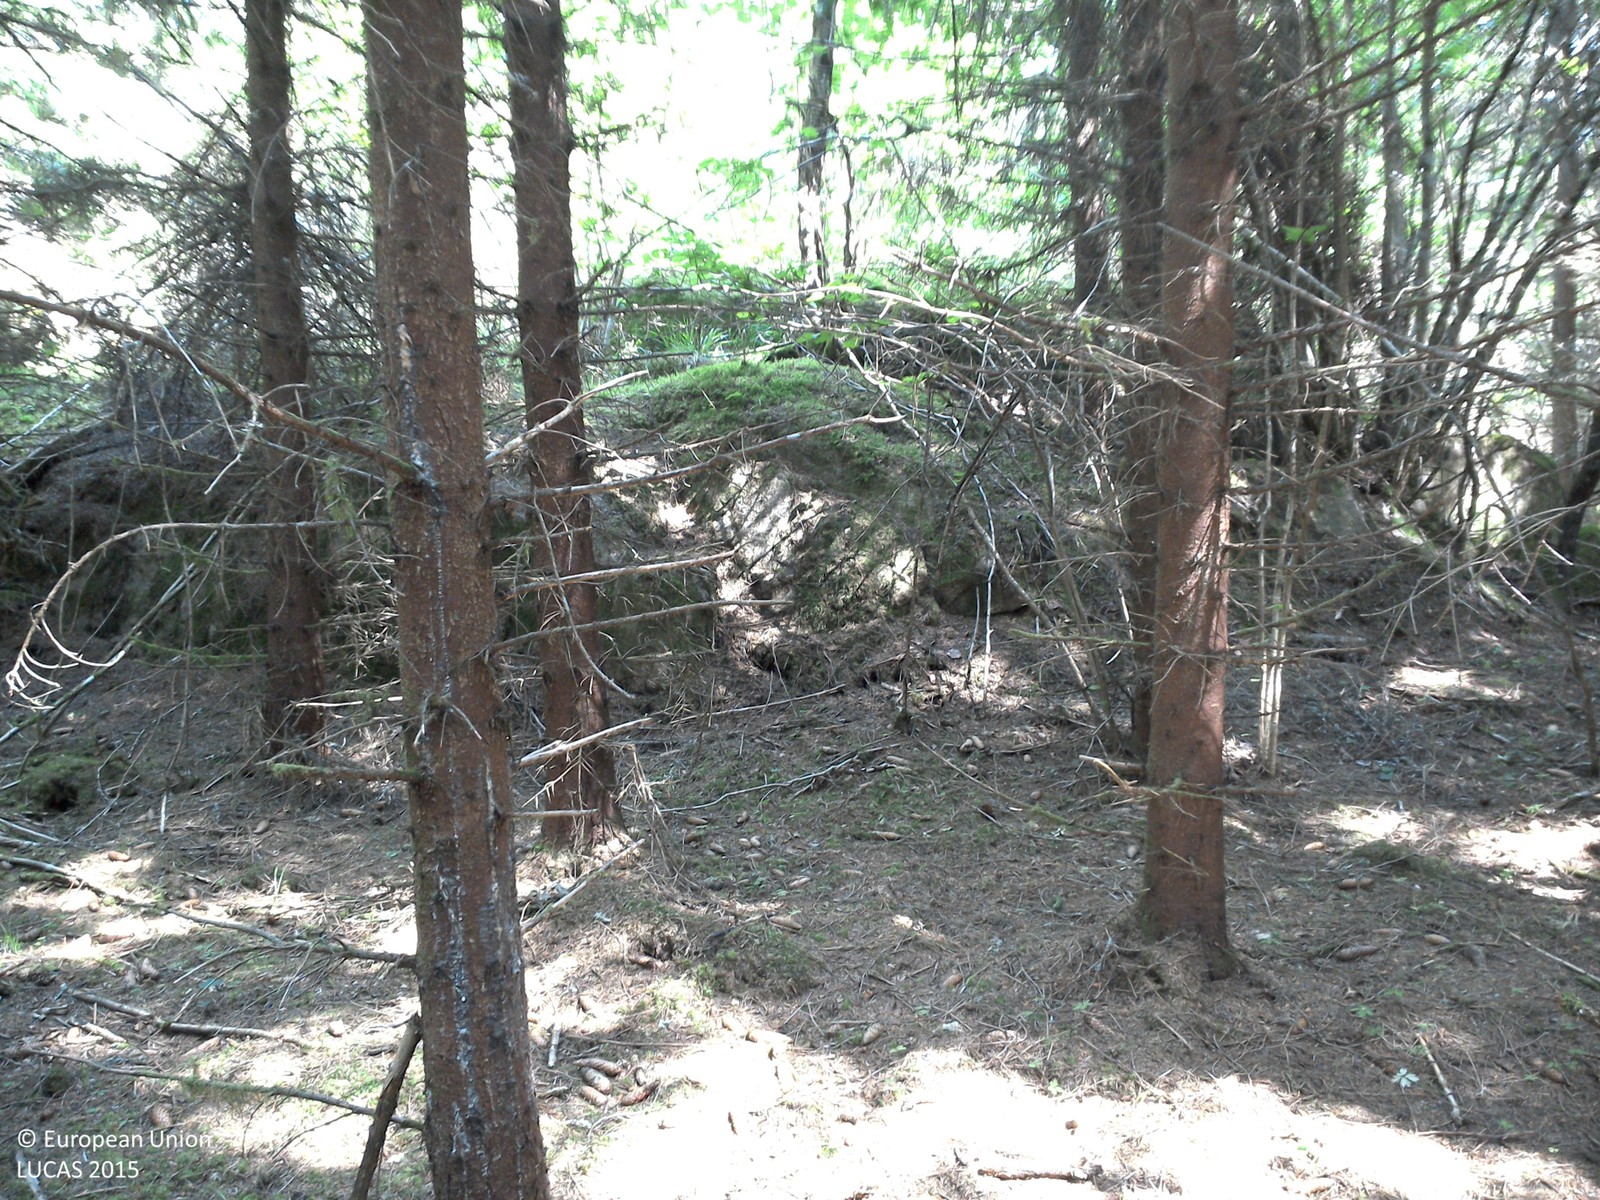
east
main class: Woodland
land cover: Spruce dominated coniferous woodland
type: boreal forest
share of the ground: > 75 %
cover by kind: coniferous forest trees 80 %, lichens and mosses 20 %
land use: Forestry
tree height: > 5 m
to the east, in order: Spruce dominated coniferous woodland
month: July
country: SE
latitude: 58.0871
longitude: 14.5907
